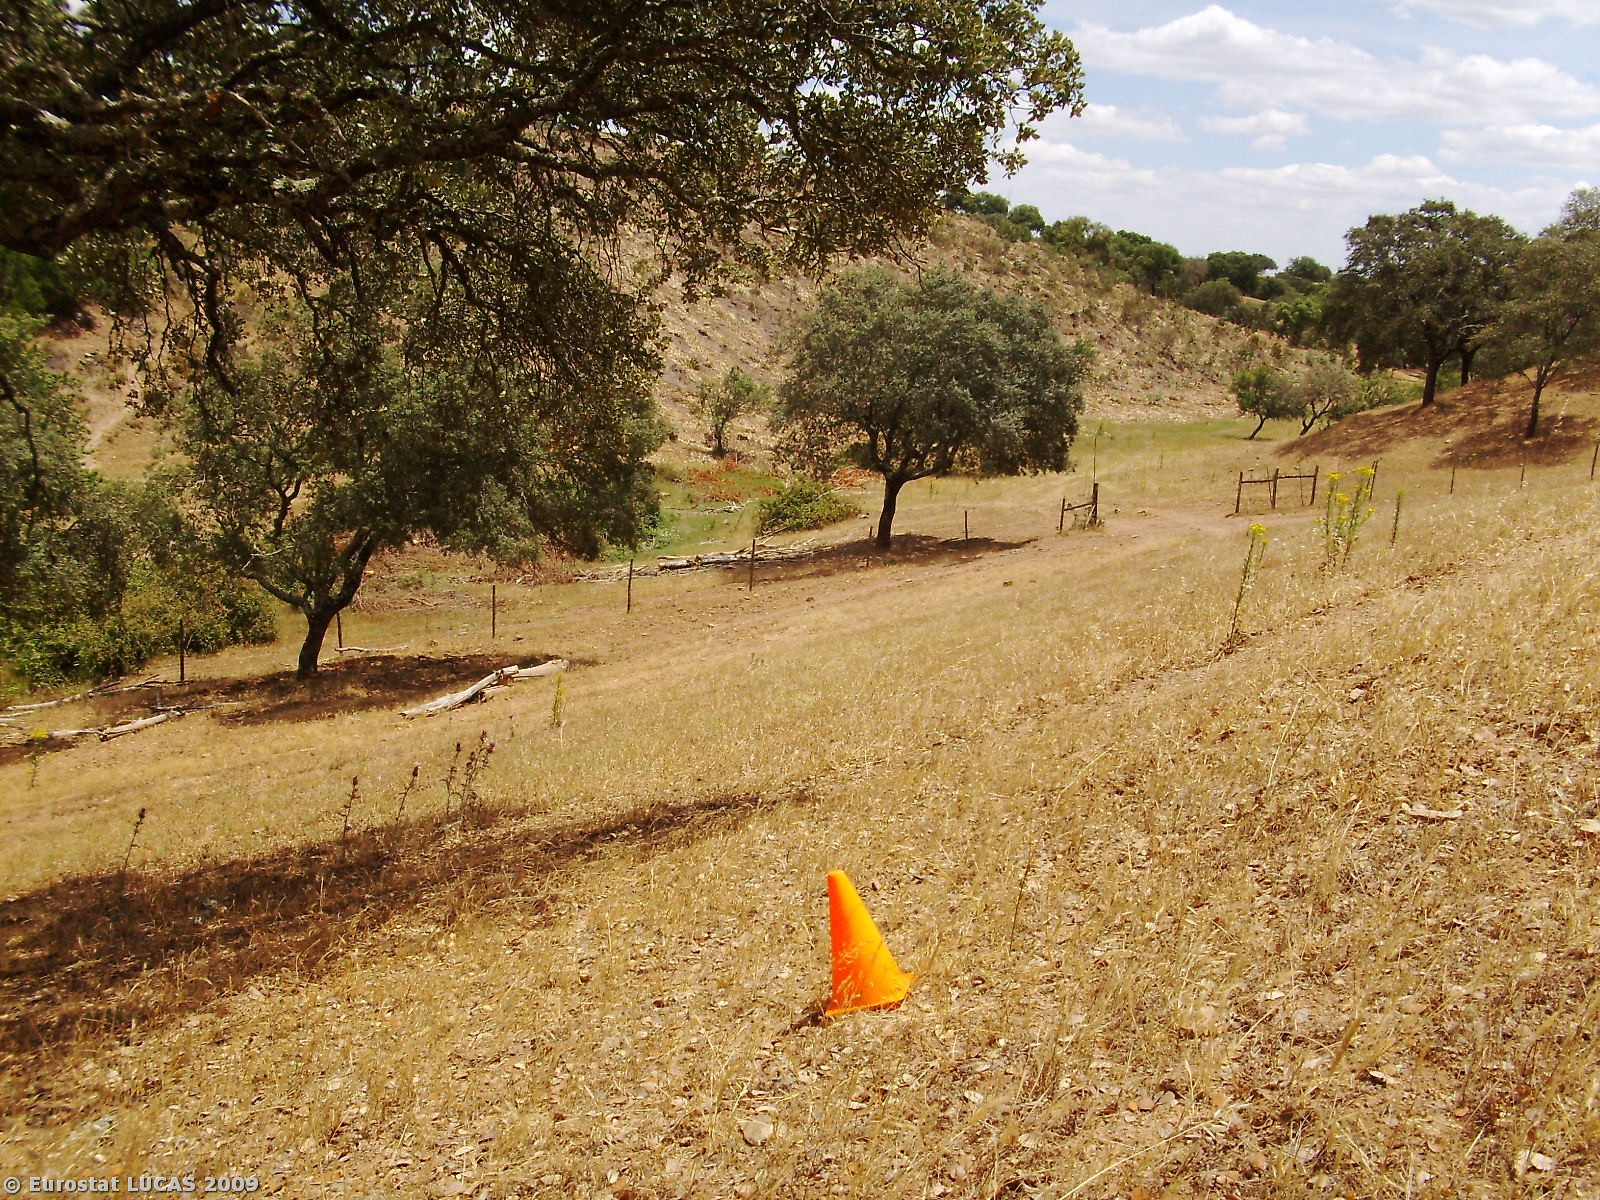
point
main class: Woodland
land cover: Broadleaved woodland
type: broadleaved evergreen forest
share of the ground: 10 - 25 %
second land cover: Spontaneously vegetated surfaces
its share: 50 - 75 %
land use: Forestry
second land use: Fallow land
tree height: > 5 m
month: June
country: PT
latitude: 38.0608
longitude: -8.5199
